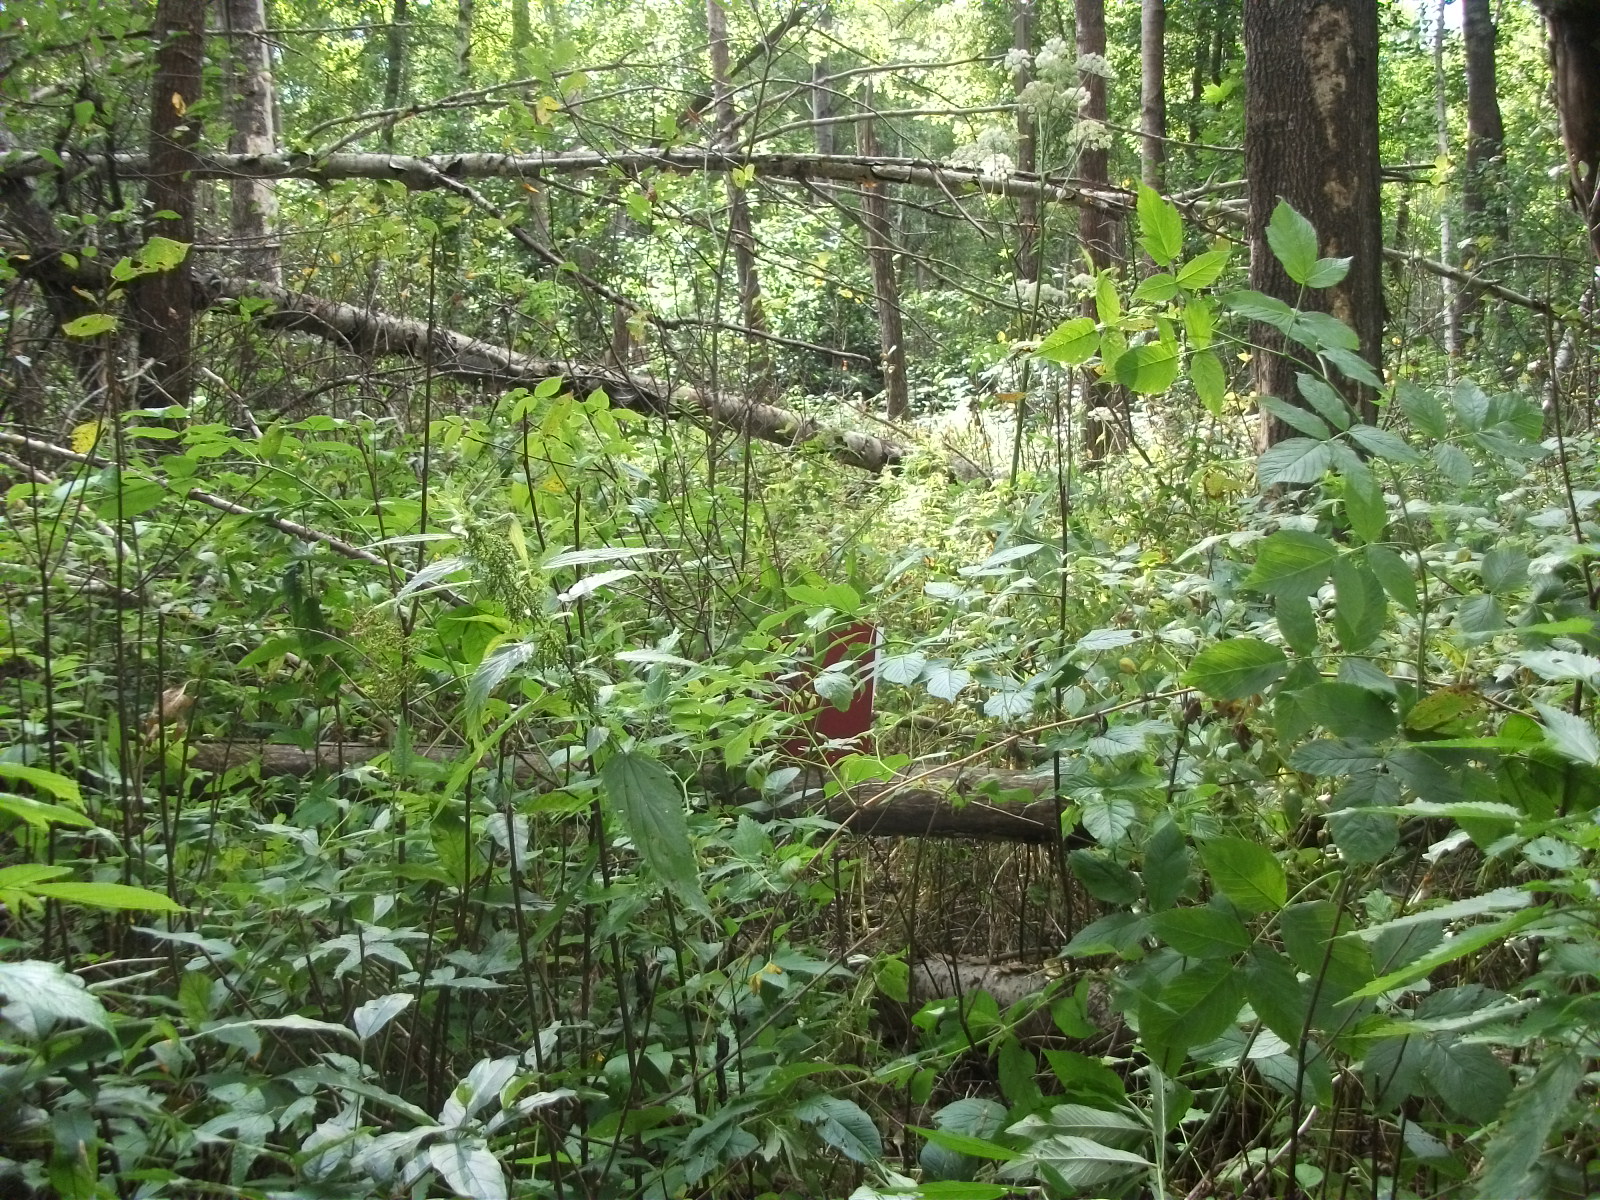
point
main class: Woodland
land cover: Broadleaved woodland
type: non-riverine alder, birch or aspen forest
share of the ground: > 75 %
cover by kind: broadleaved forest trees 80 %, shrubs 10 %, herbaceous plants 10 %
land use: Forestry
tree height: > 5 m
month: August
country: LV
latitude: 56.3961
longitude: 26.3615
